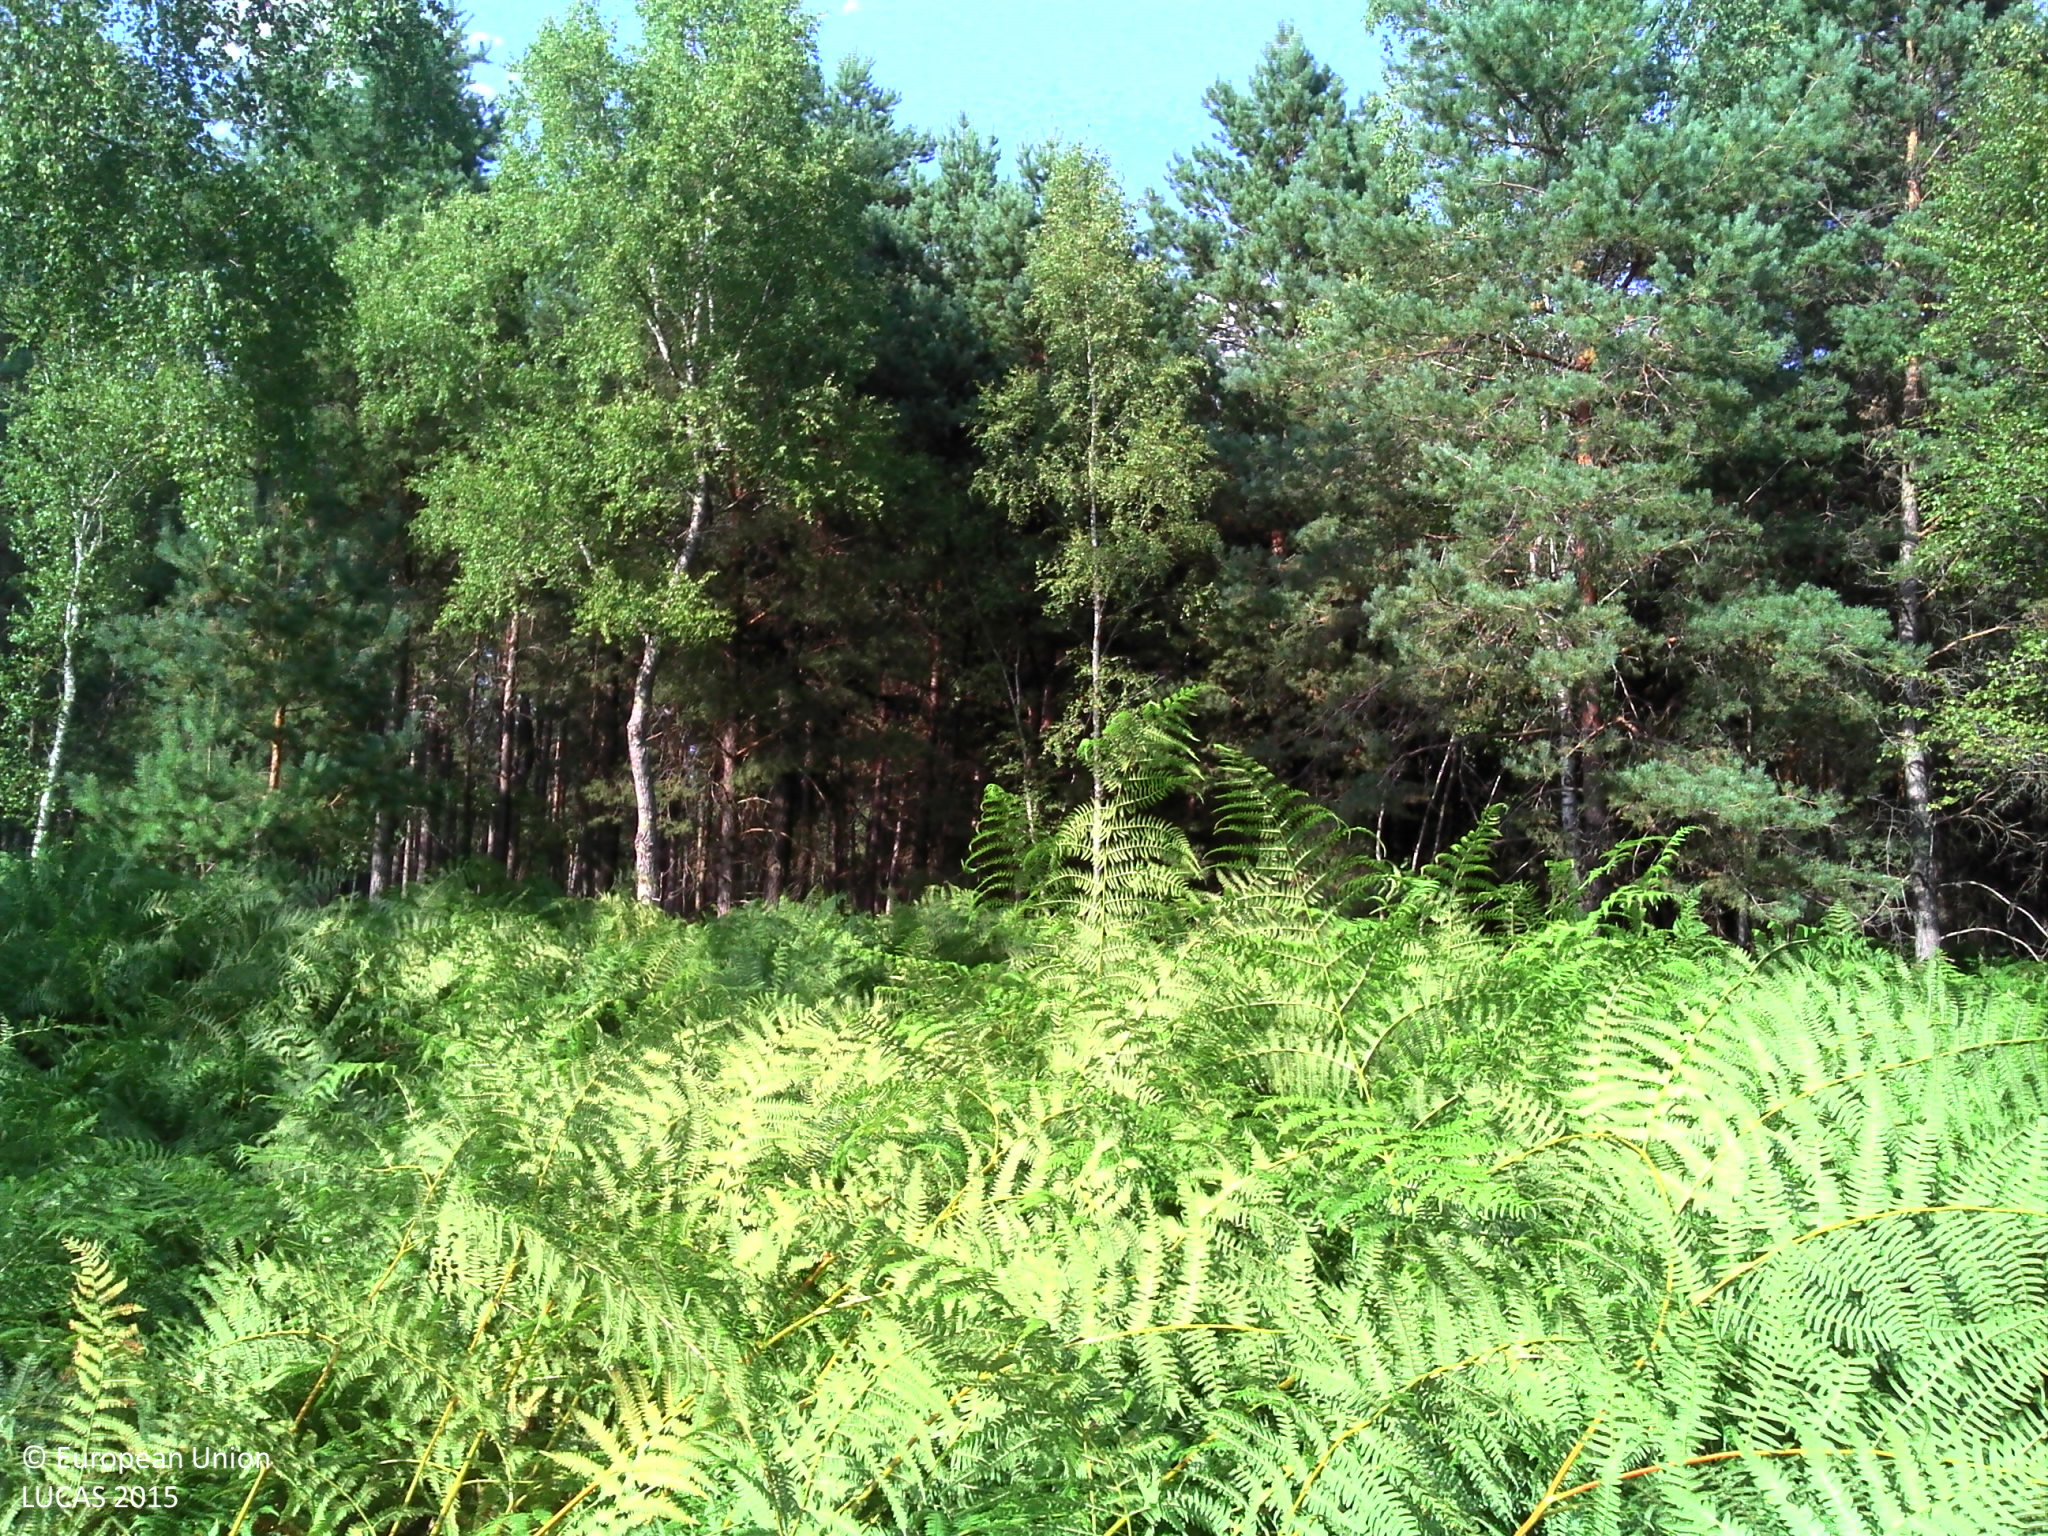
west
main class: Woodland
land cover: Broadleaved woodland
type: acidophilous oak and oak-birch forest
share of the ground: 25 - 50 %
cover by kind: herbaceous plants 60 %, broadleaved forest trees 40 %
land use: Forestry
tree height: > 5 m
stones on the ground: < 10 %
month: August
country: FR
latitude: 47.3639
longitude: 2.1385
